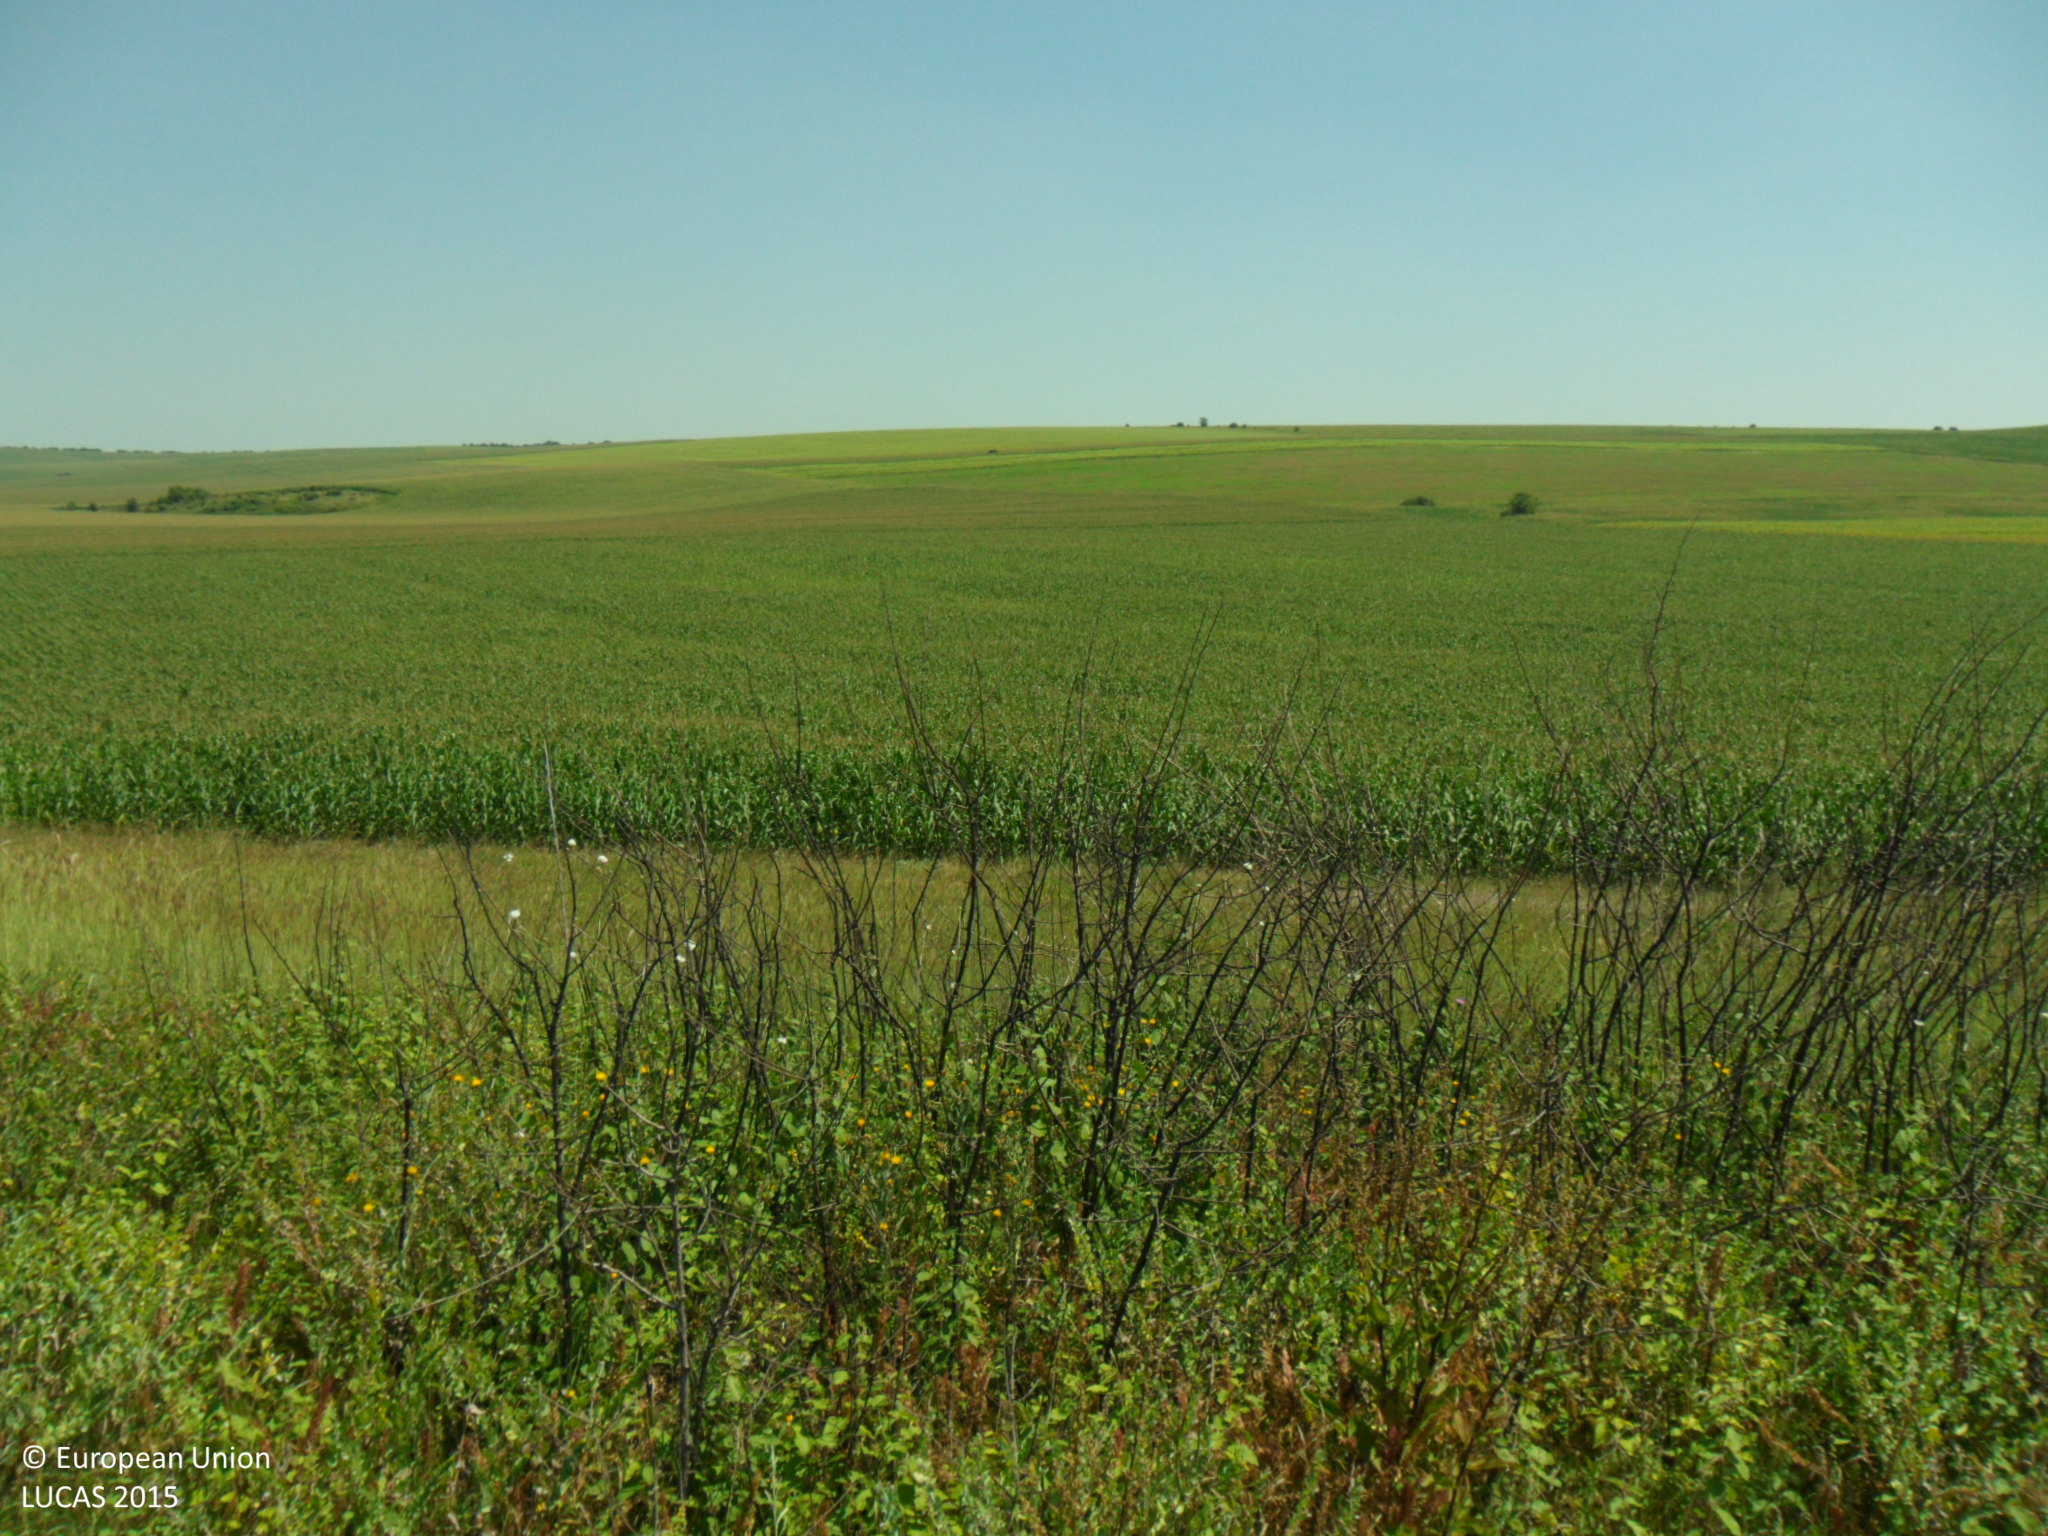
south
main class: Grassland
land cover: Grassland without tree/shrub cover
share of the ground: > 75 %
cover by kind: herbaceous plants 100 %
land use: Agriculture (excluding fallow land and kitchen gardens)
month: July
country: BG
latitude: 43.9174
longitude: 26.5111
